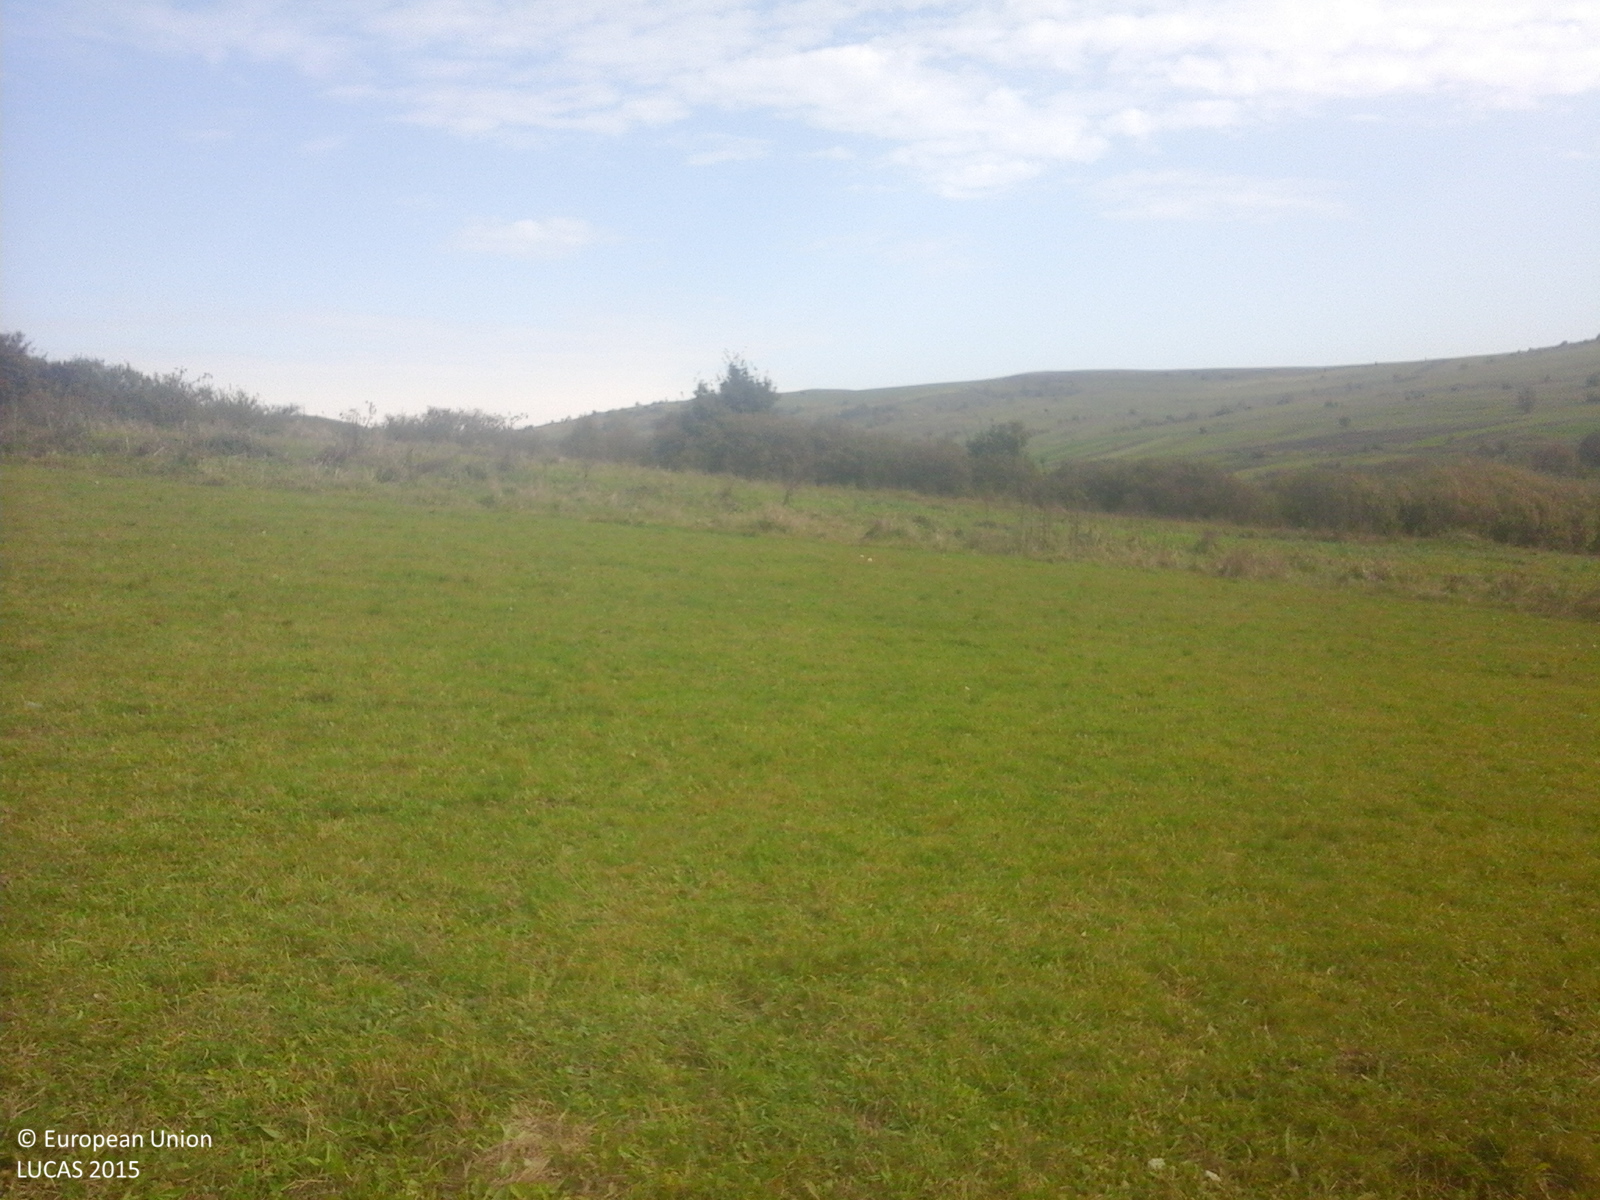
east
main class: Grassland
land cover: Grassland without tree/shrub cover
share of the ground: > 75 %
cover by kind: herbaceous plants 100 %
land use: Agriculture (excluding fallow land and kitchen gardens)
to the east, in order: Grassland without tree/shrub cover; Shrubland with sparse tree cover; Grassland with sparse tree/shrub cover; Tracks; Grassland with sparse tree/shrub cover; Lines of trees
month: October
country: RO
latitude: 46.2474
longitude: 25.3169
